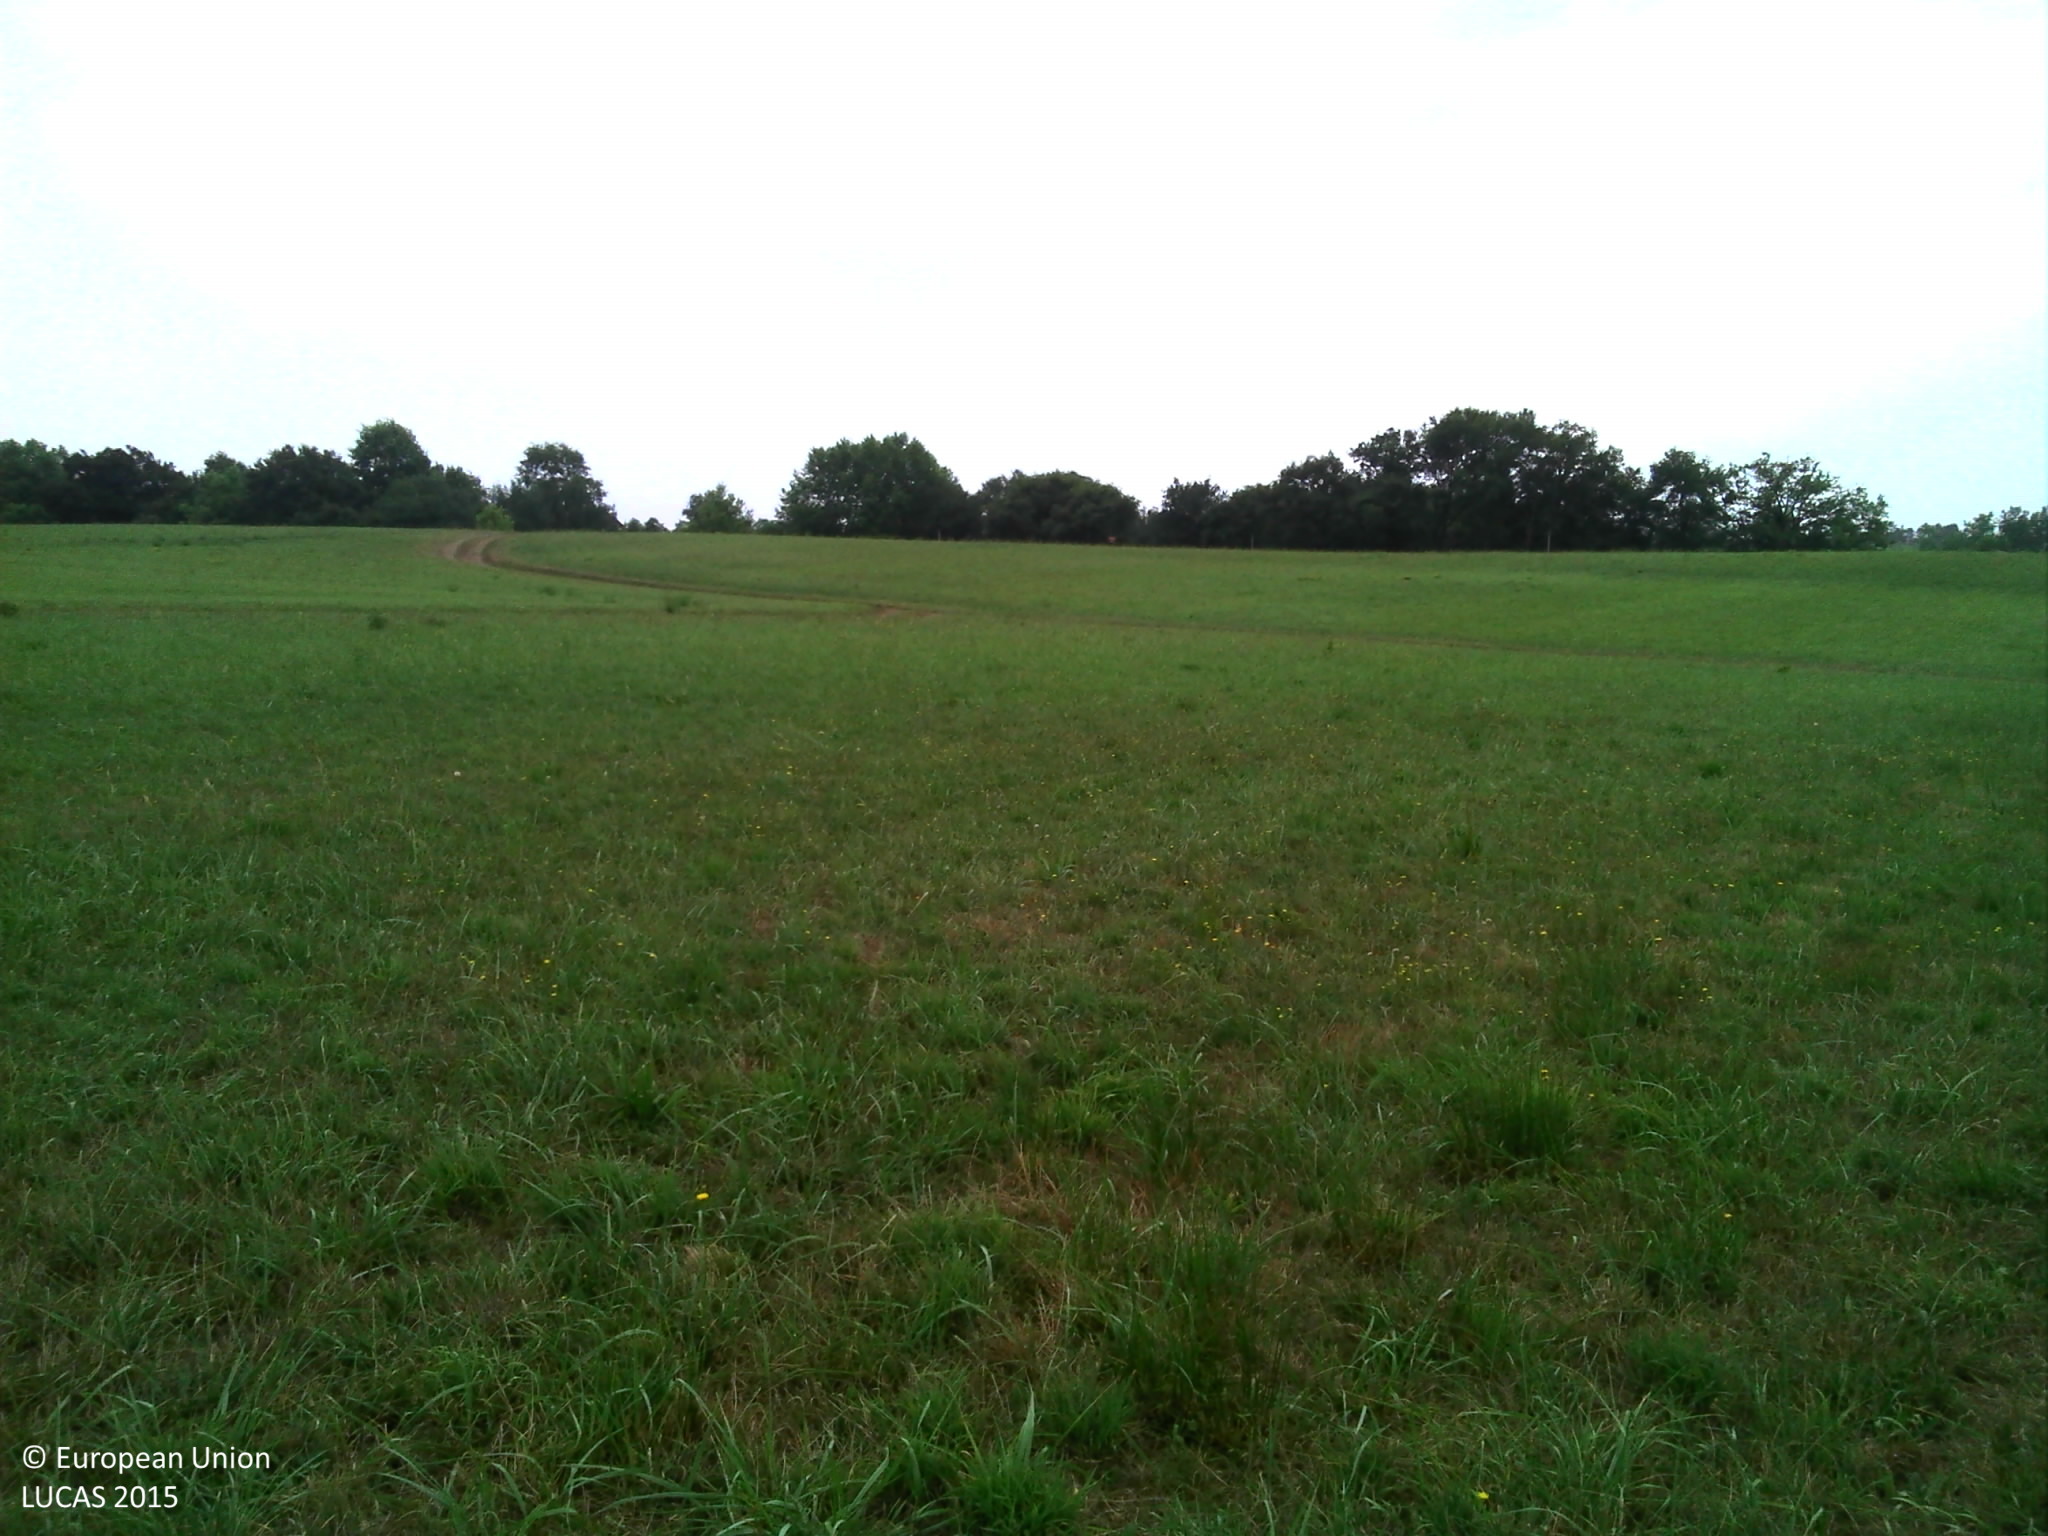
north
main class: Grassland
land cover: Grassland without tree/shrub cover
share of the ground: > 75 %
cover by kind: herbaceous plants 100 %
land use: Agriculture (excluding fallow land and kitchen gardens)
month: July
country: FR
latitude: 43.6321
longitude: -1.2089
